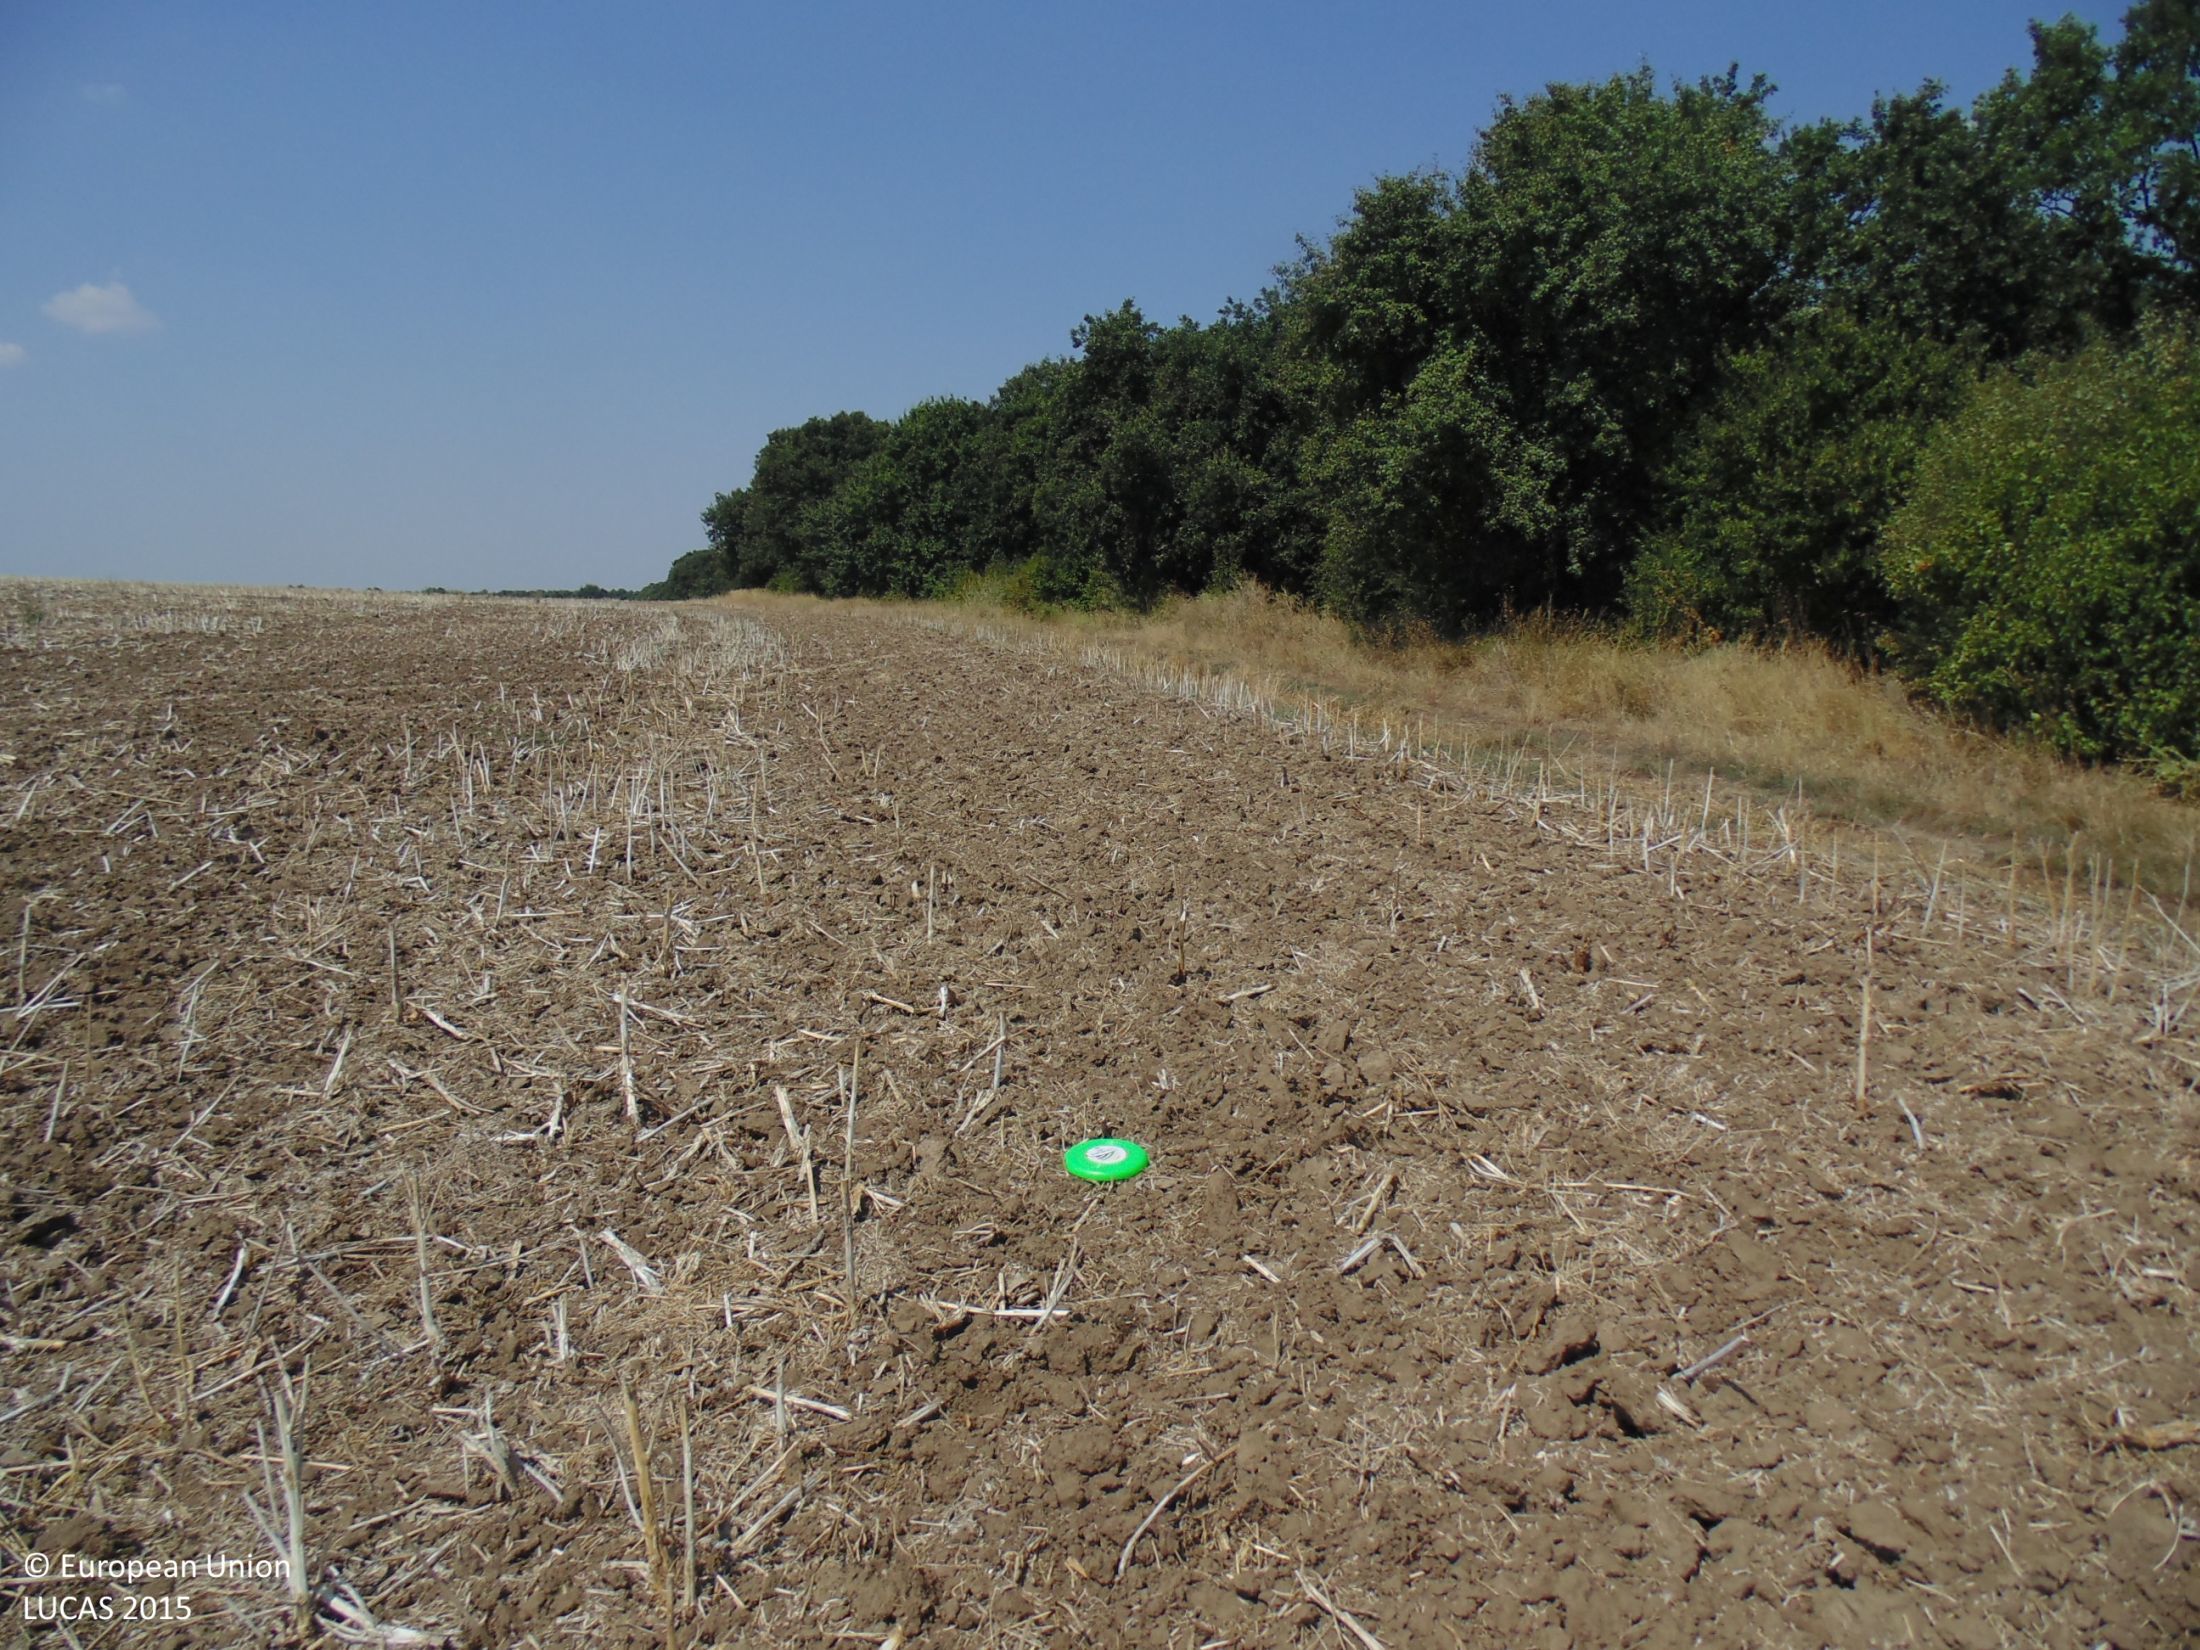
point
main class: Cropland
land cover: Rape and turnip rape
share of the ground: 10 - 25 %
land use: Agriculture (excluding fallow land and kitchen gardens)
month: August
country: BG
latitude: 43.9952
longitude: 27.5849
